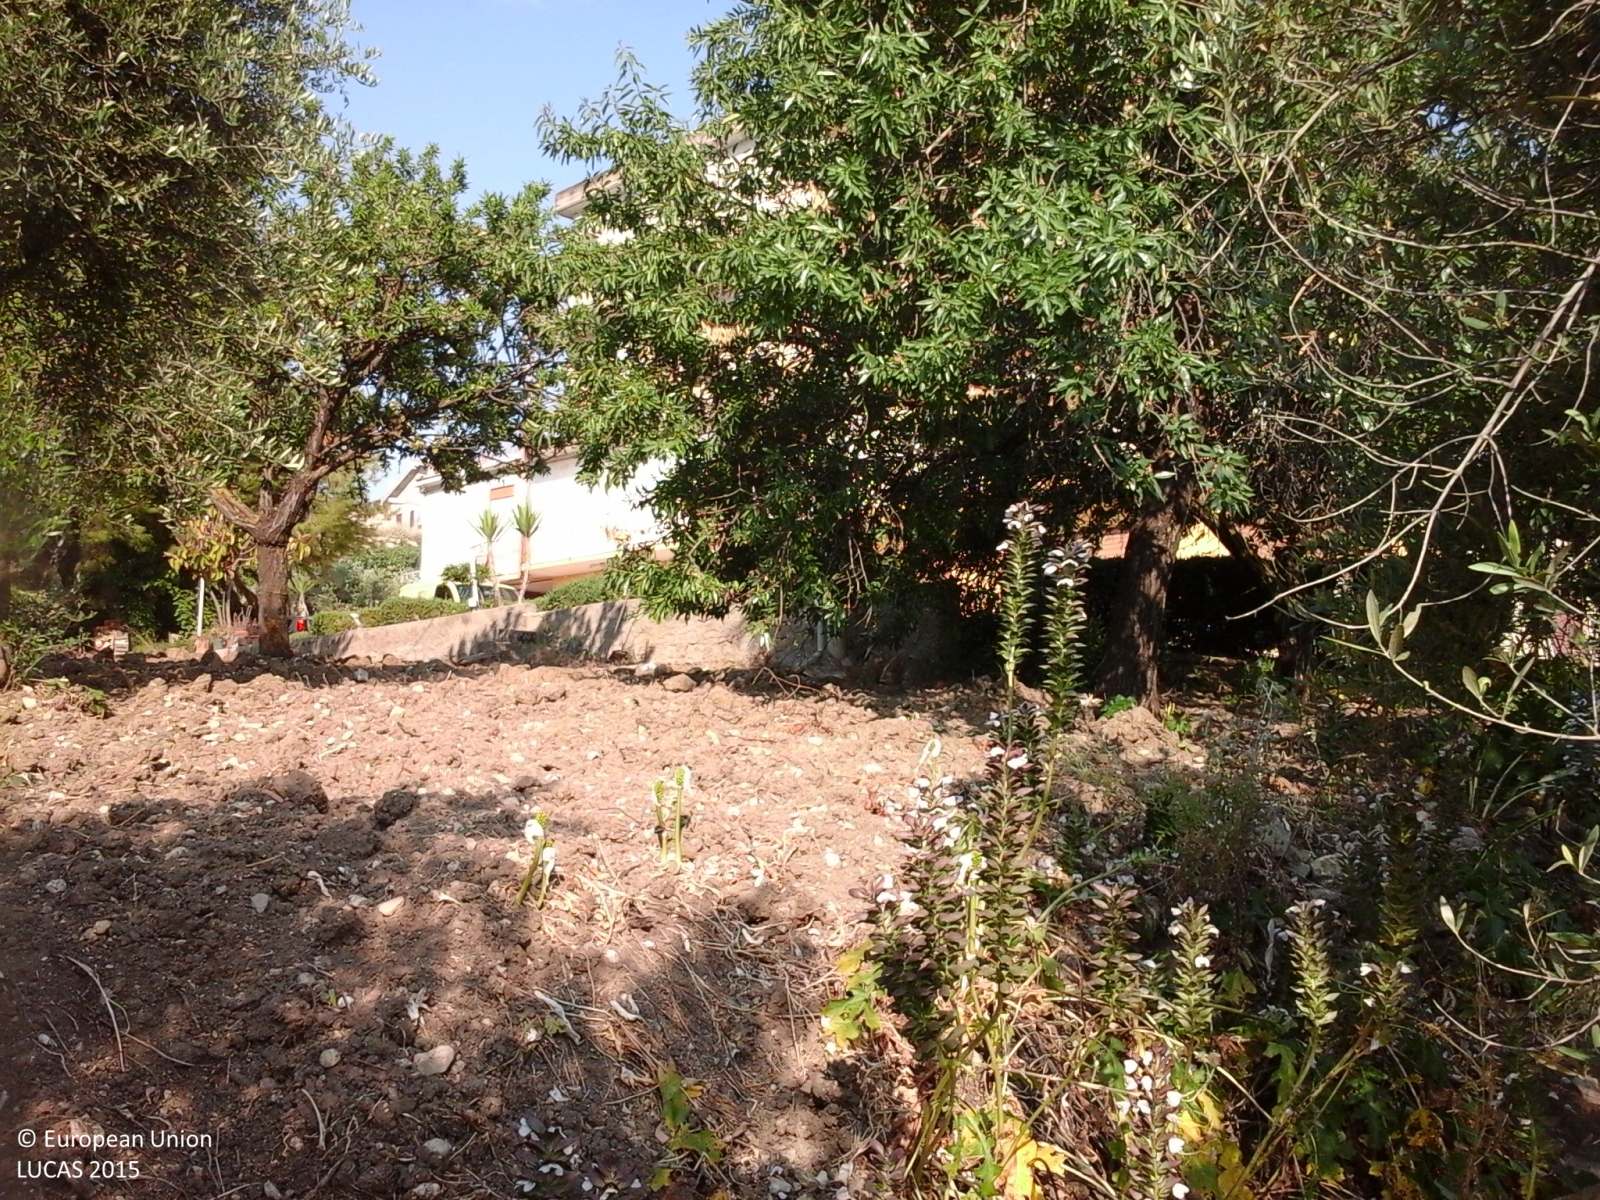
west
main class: Cropland
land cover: Olive groves
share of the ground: 25 - 50 %
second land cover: Spontaneously vegetated surfaces
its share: > 75 %
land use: Agriculture (excluding fallow land and kitchen gardens)
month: June
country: IT
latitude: 37.3912
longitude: 13.5307
